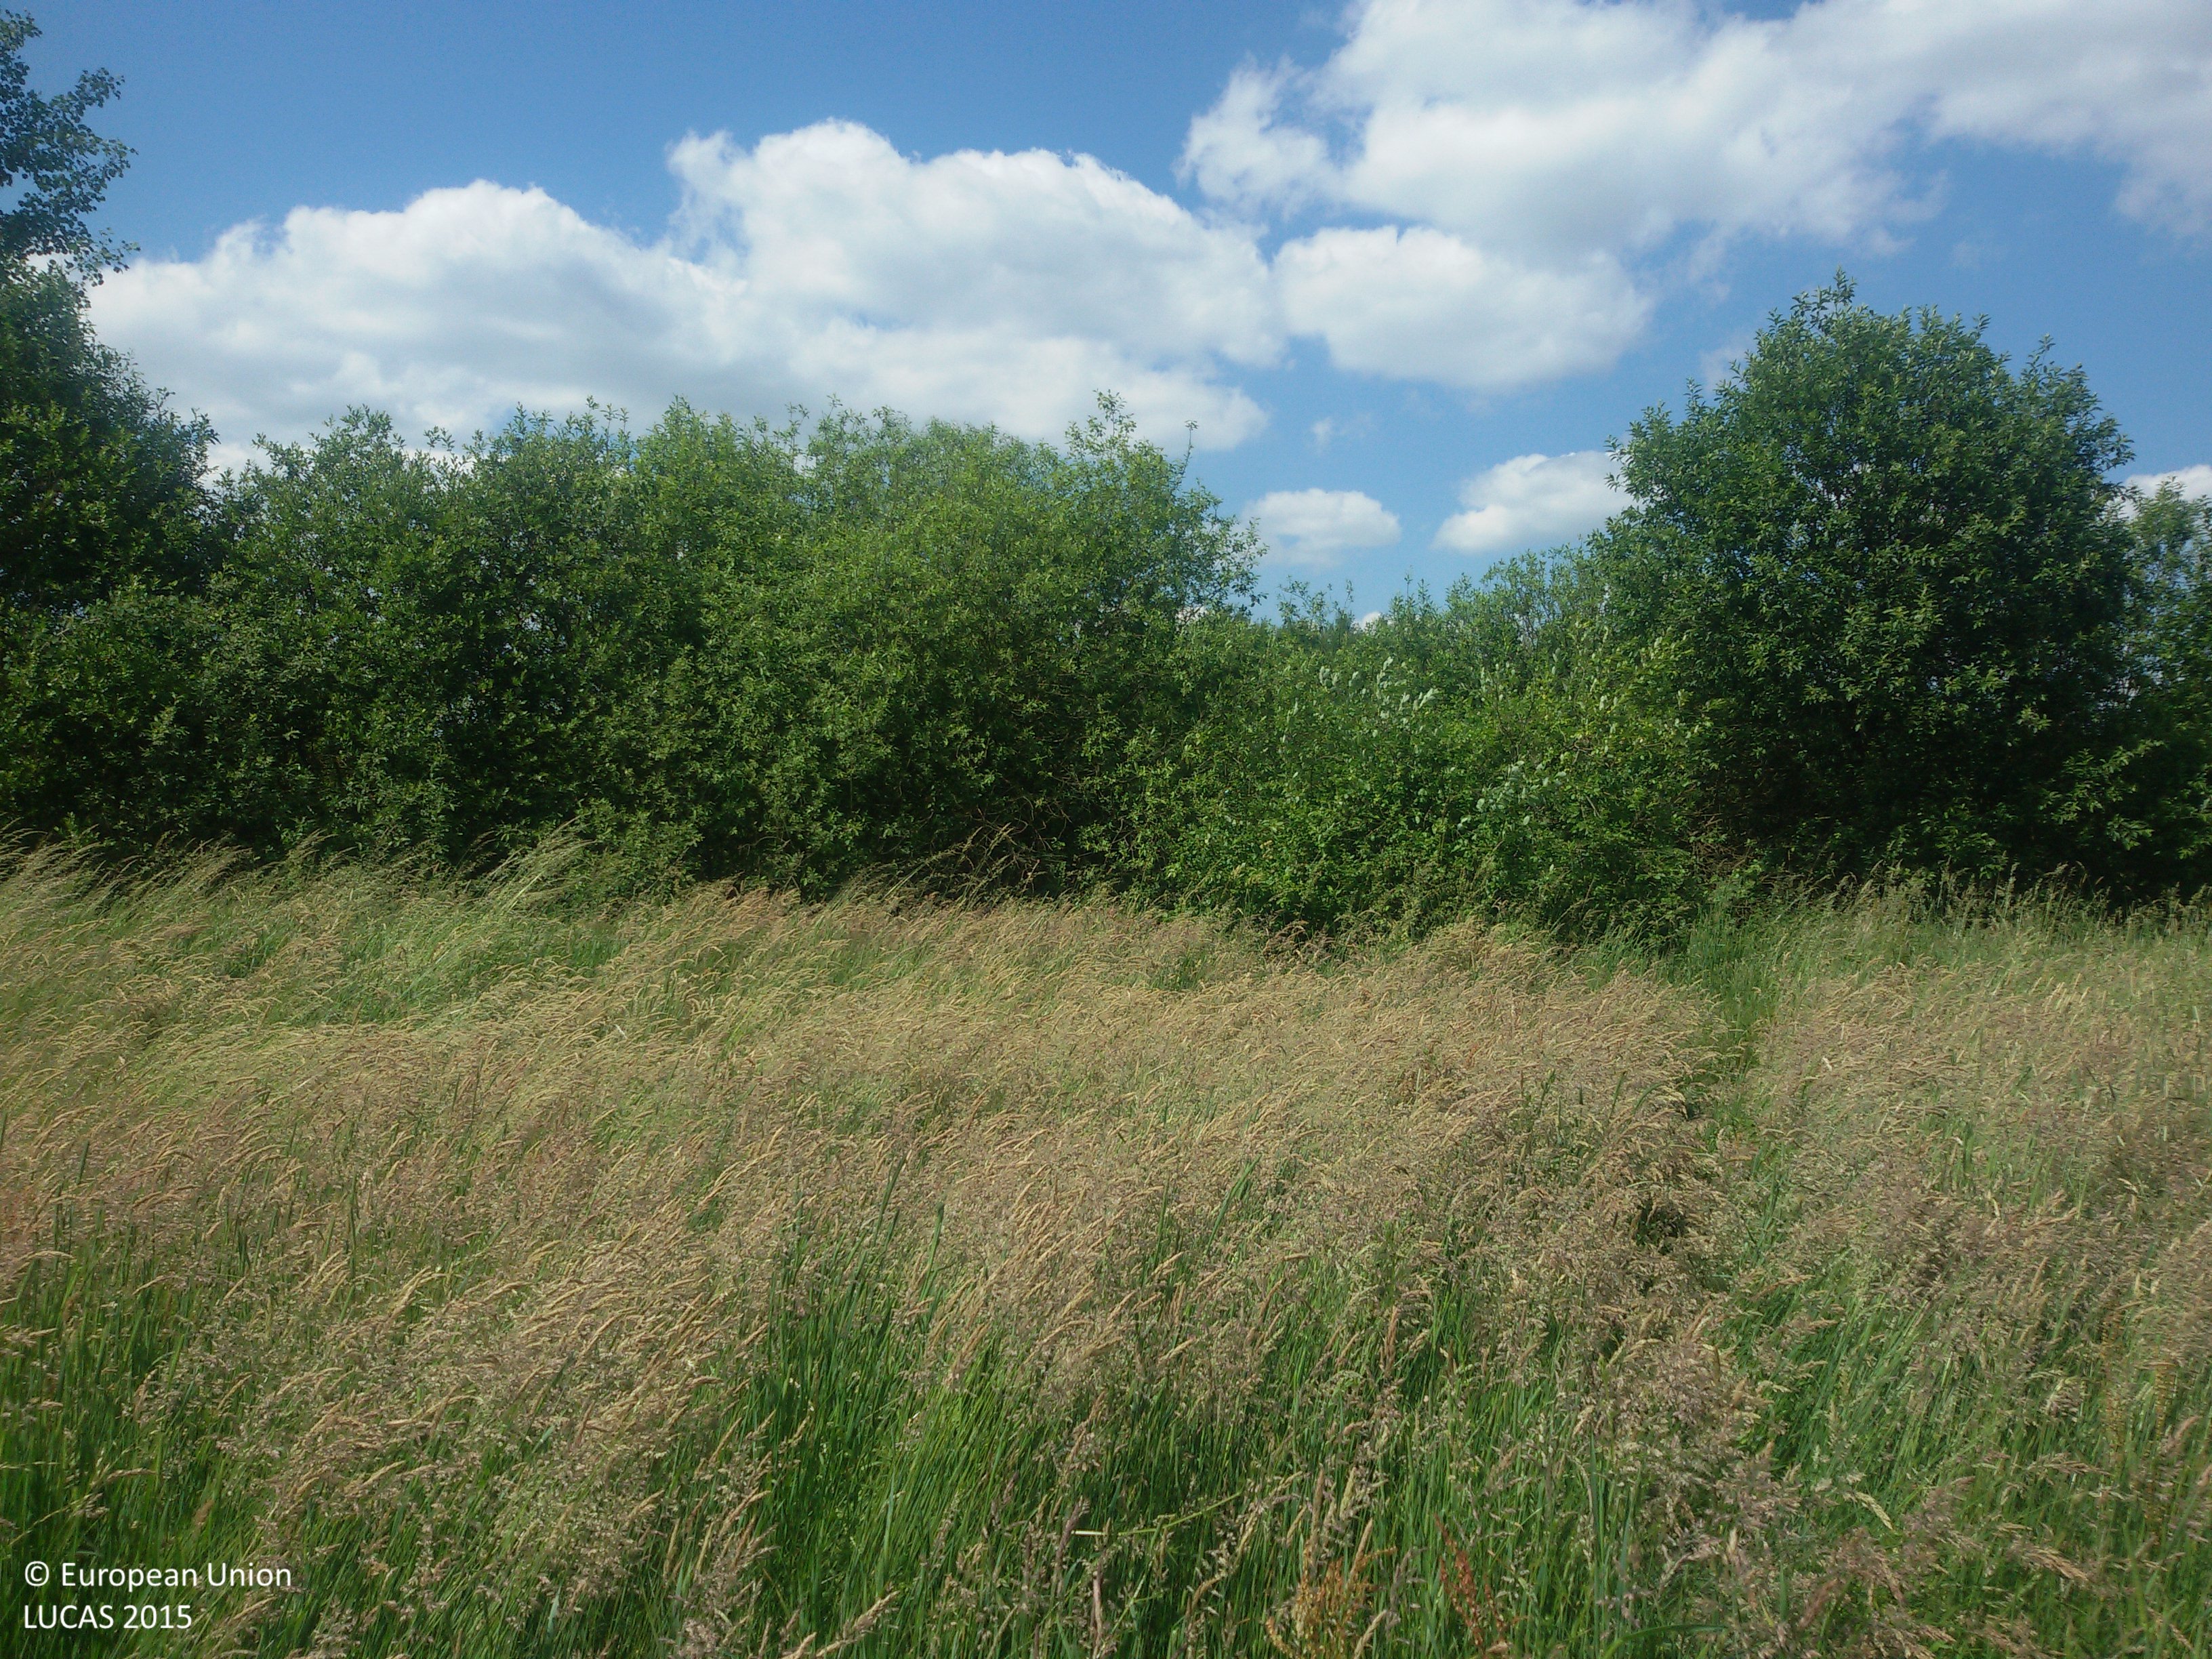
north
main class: Grassland
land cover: Grassland without tree/shrub cover
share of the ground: > 75 %
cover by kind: herbaceous plants 100 %
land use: Agriculture (excluding fallow land and kitchen gardens)
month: June
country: PL
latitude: 51.5703
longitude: 22.8115
